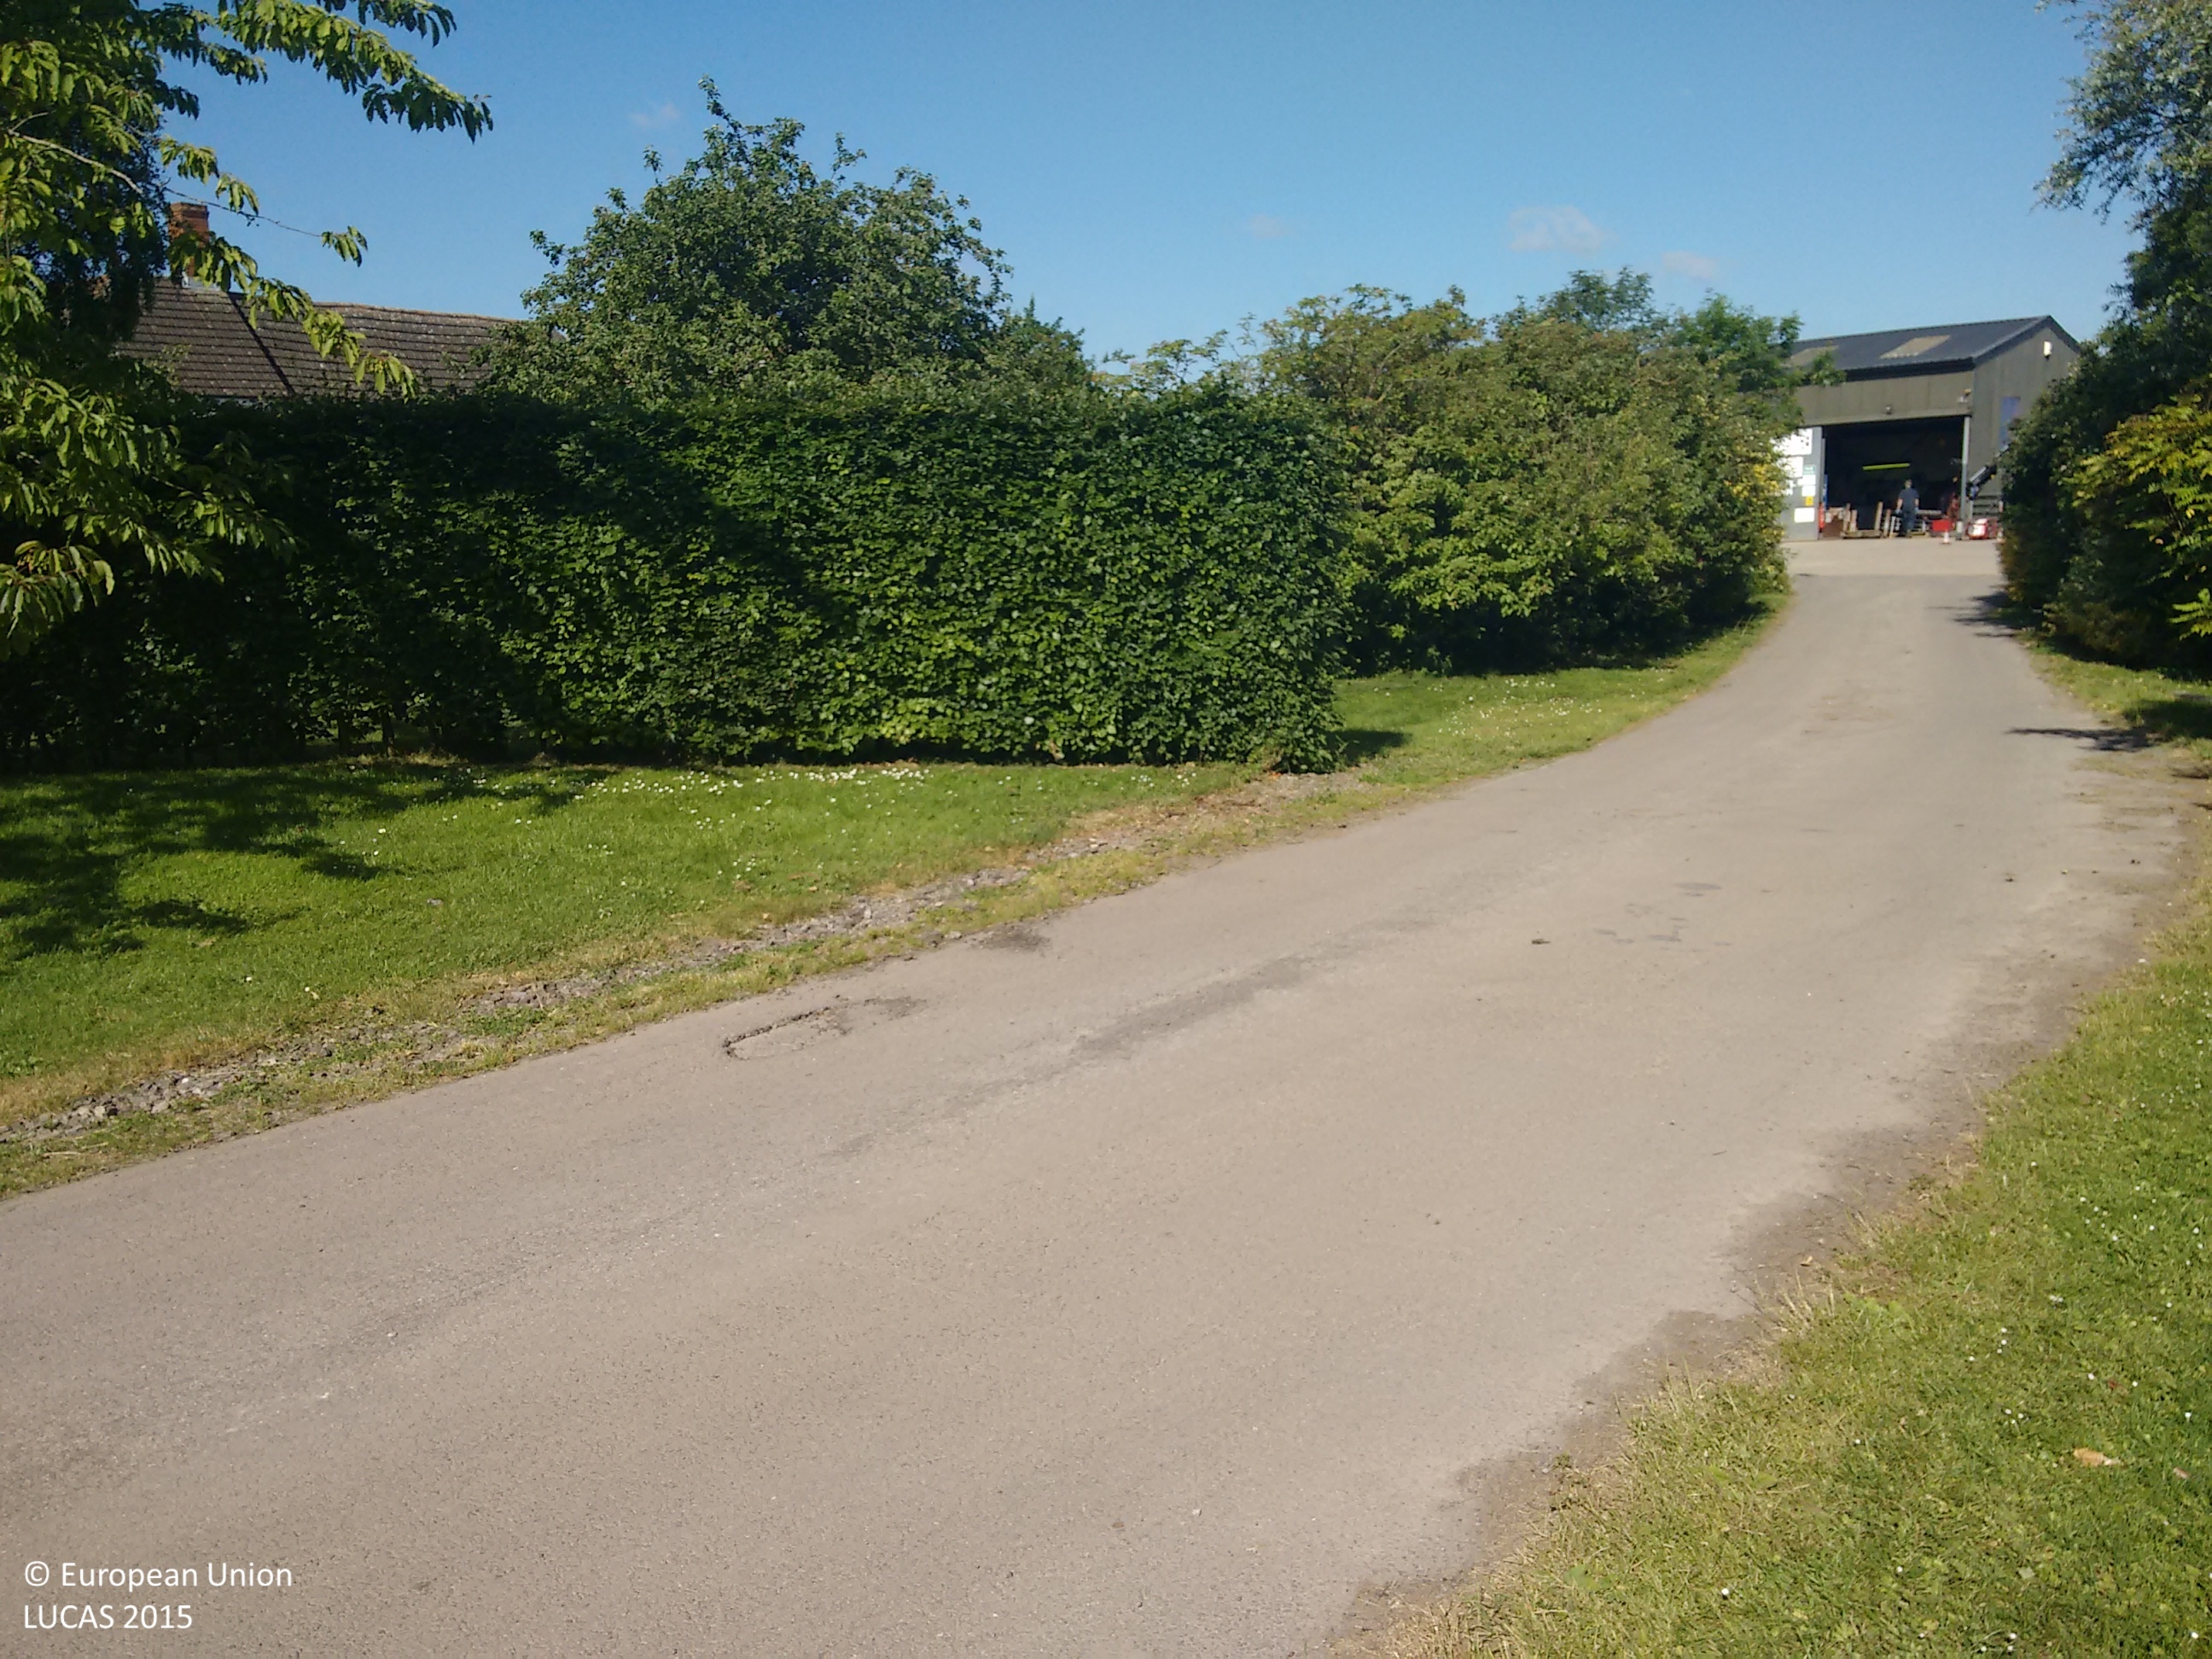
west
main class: Grassland
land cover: Grassland with sparse tree/shrub cover
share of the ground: > 75 %
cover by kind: herbaceous plants 95 %, broadleaved forest trees 5 %
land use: Agriculture (excluding fallow land and kitchen gardens)
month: June
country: GB
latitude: 51.4020
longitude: -2.0038
